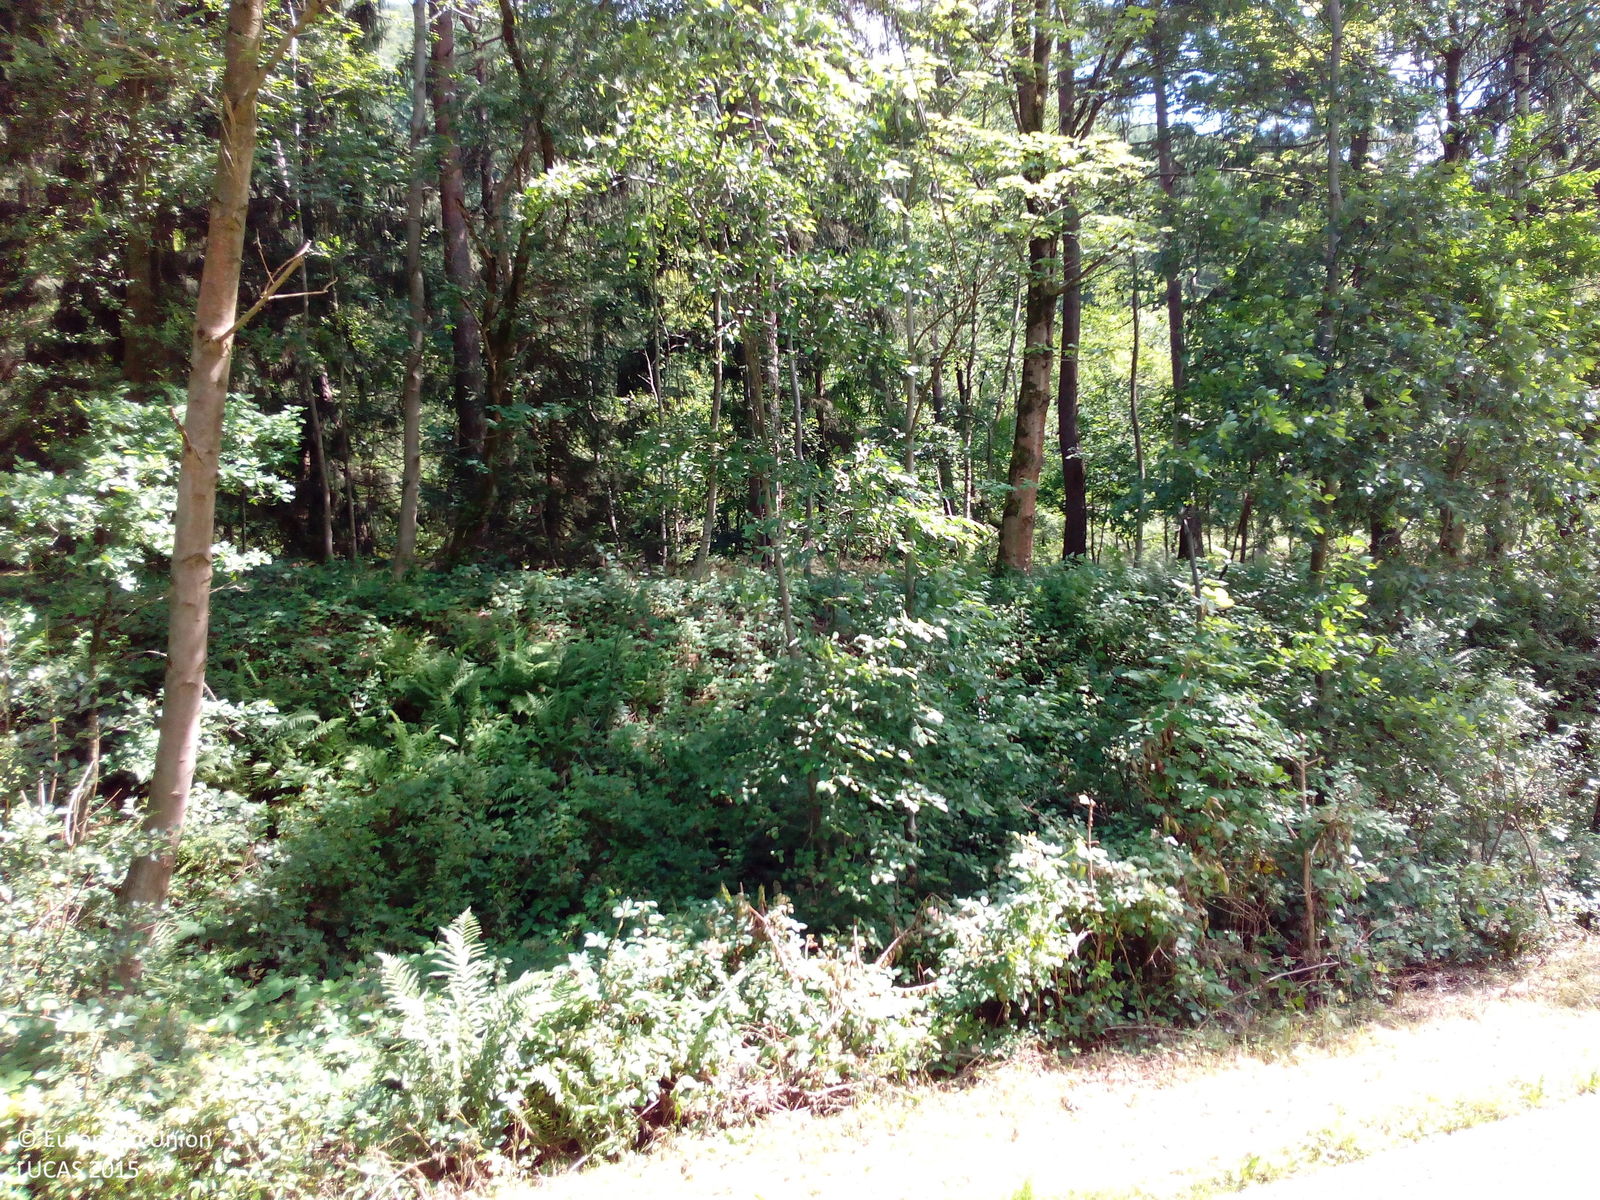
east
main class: Woodland
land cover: Broadleaved woodland
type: thermophilous deciduous forest
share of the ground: > 75 %
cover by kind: broadleaved forest trees 100 %
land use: Forestry
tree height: > 5 m
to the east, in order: Broadleaved woodland; Ditches and canals; Grass margins; Tracks; Grass margins; Broadleaved woodland; Spruce dominated mixed woodland; Inland fresh running water; Pine dominated mixed woodland; Electric lines; Tracks; Broadleaved woodland; Spruce dominated coniferous woodland
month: July
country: DE
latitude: 51.8918
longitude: 10.2760
